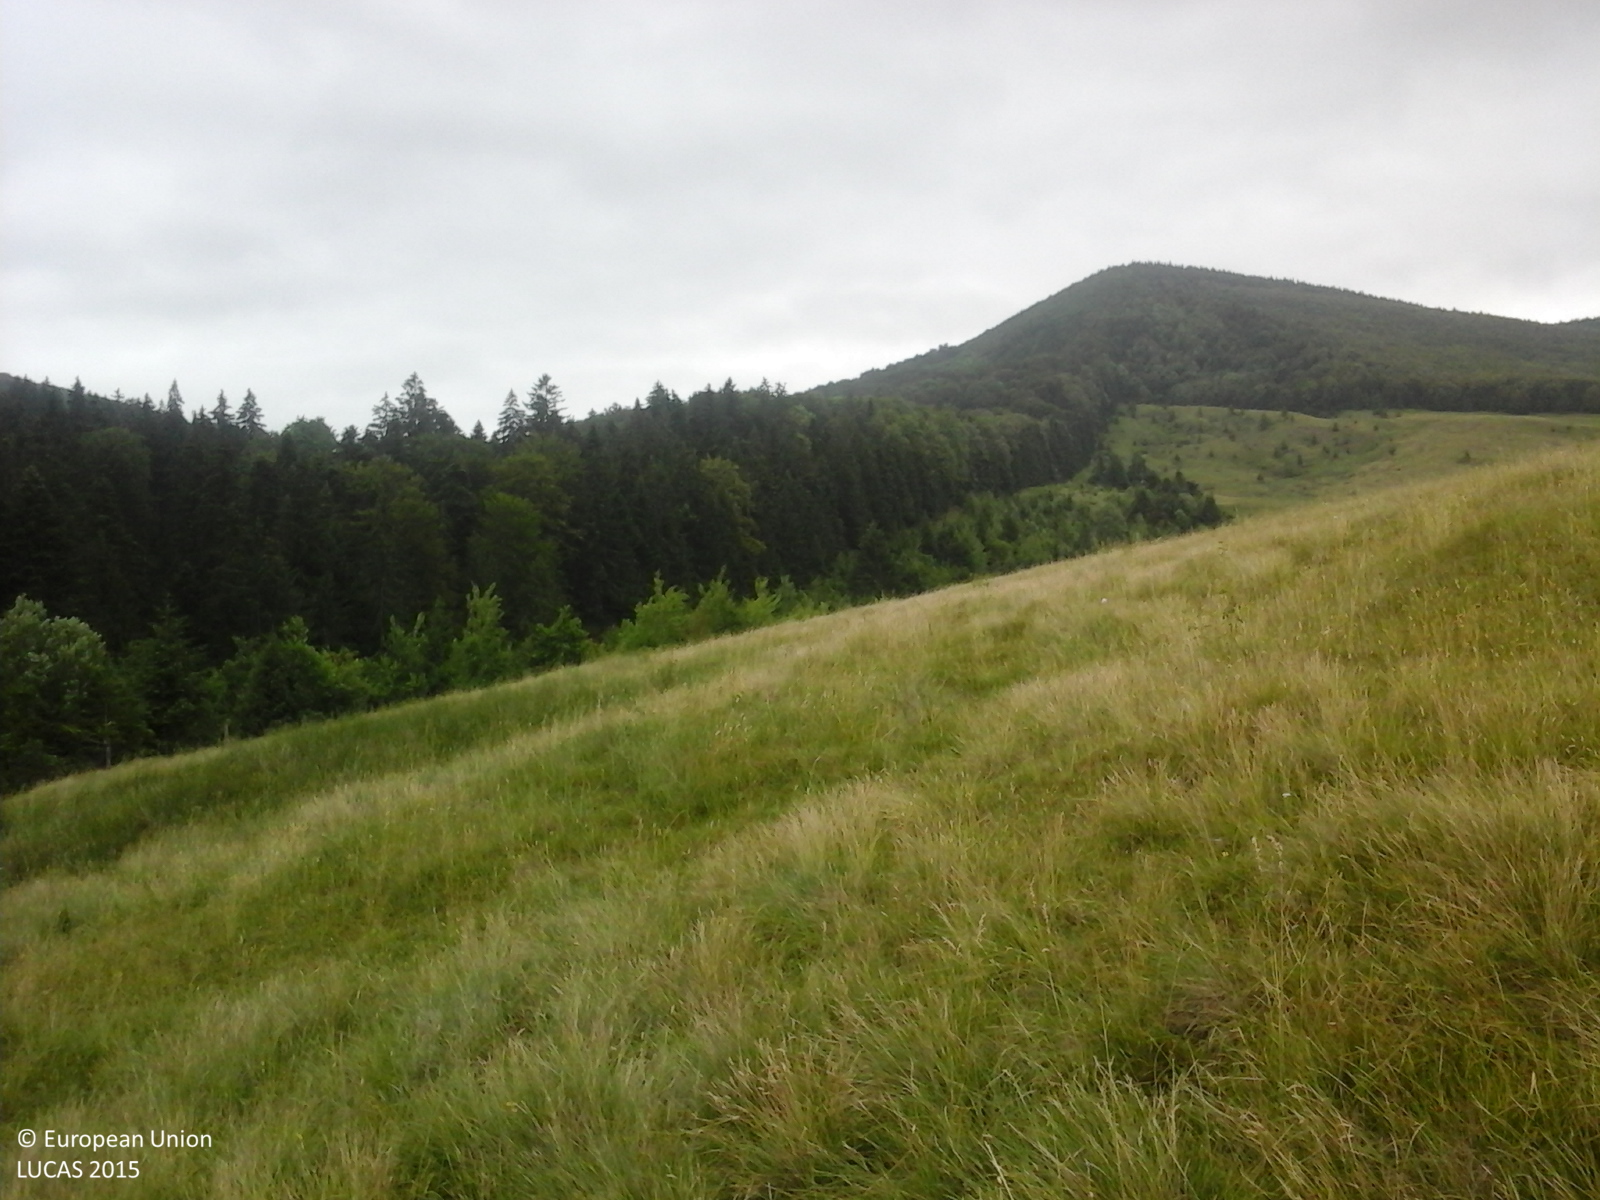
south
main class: Grassland
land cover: Grassland without tree/shrub cover
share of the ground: > 75 %
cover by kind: herbaceous plants 100 %
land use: Agriculture (excluding fallow land and kitchen gardens)
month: June
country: RO
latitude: 47.0917
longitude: 26.2975
